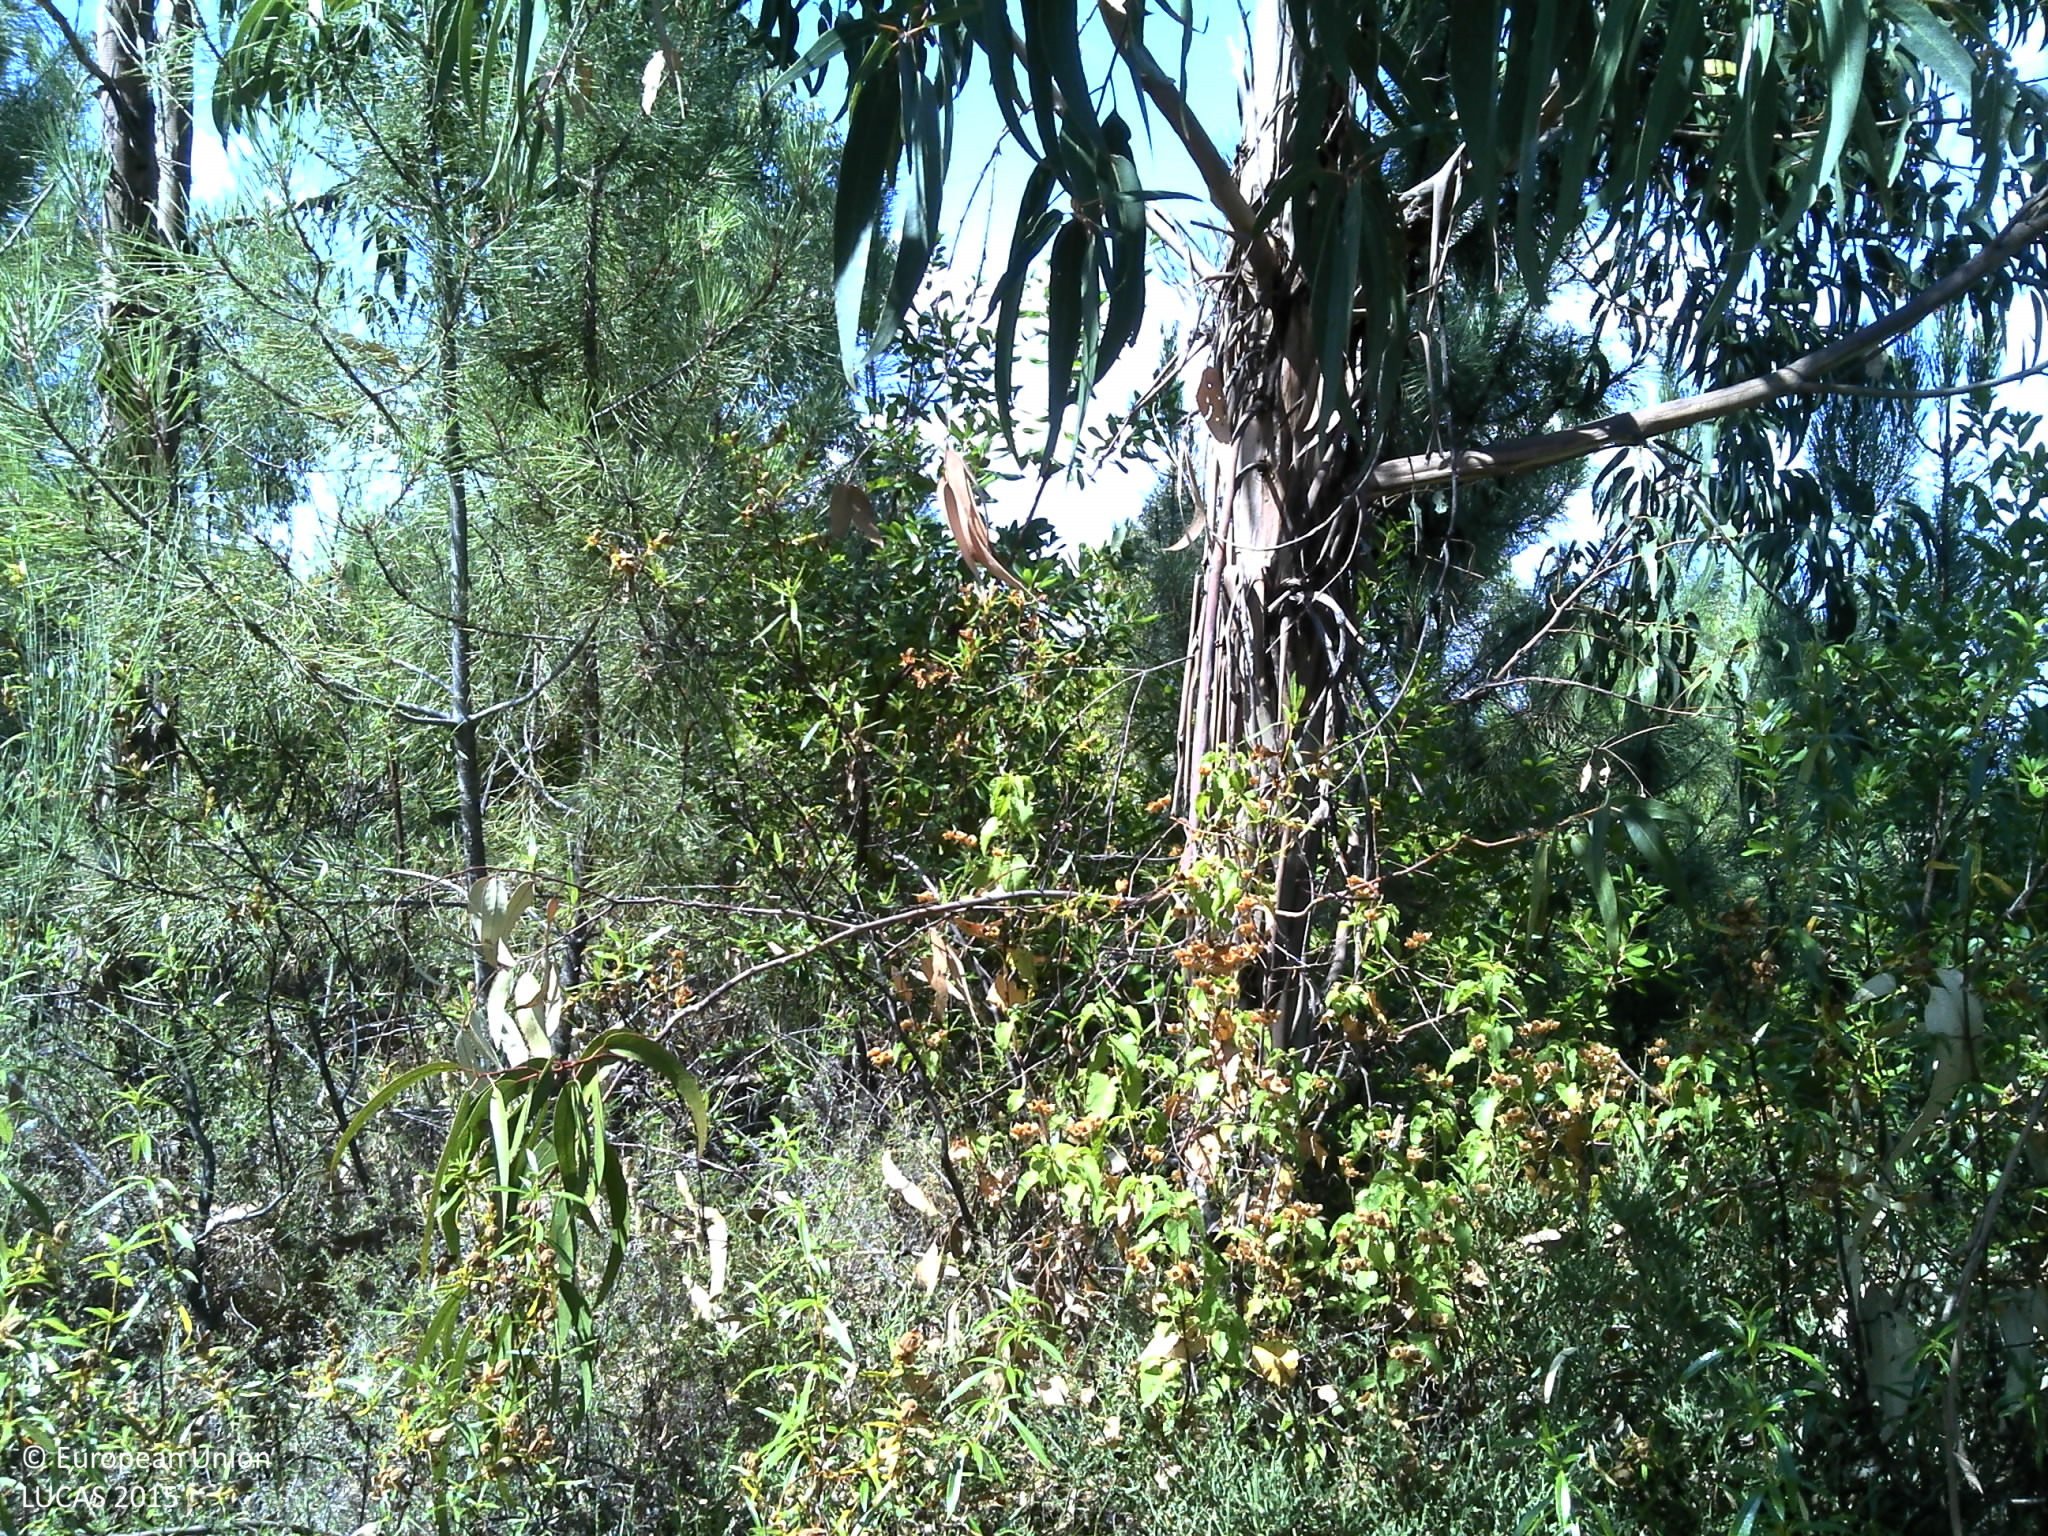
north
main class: Woodland
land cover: Pine dominated mixed woodland
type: coniferous forest of the mediterranean region
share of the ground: 25 - 50 %
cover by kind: shrubs 60 %, coniferous forest trees 15 %, broadleaved forest trees 10 %, unconsolidated bare surface 10 %, consolidated bare surface 5 %
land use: Forestry
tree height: > 5 m
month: July
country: PT
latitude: 39.8066
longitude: -7.8022
